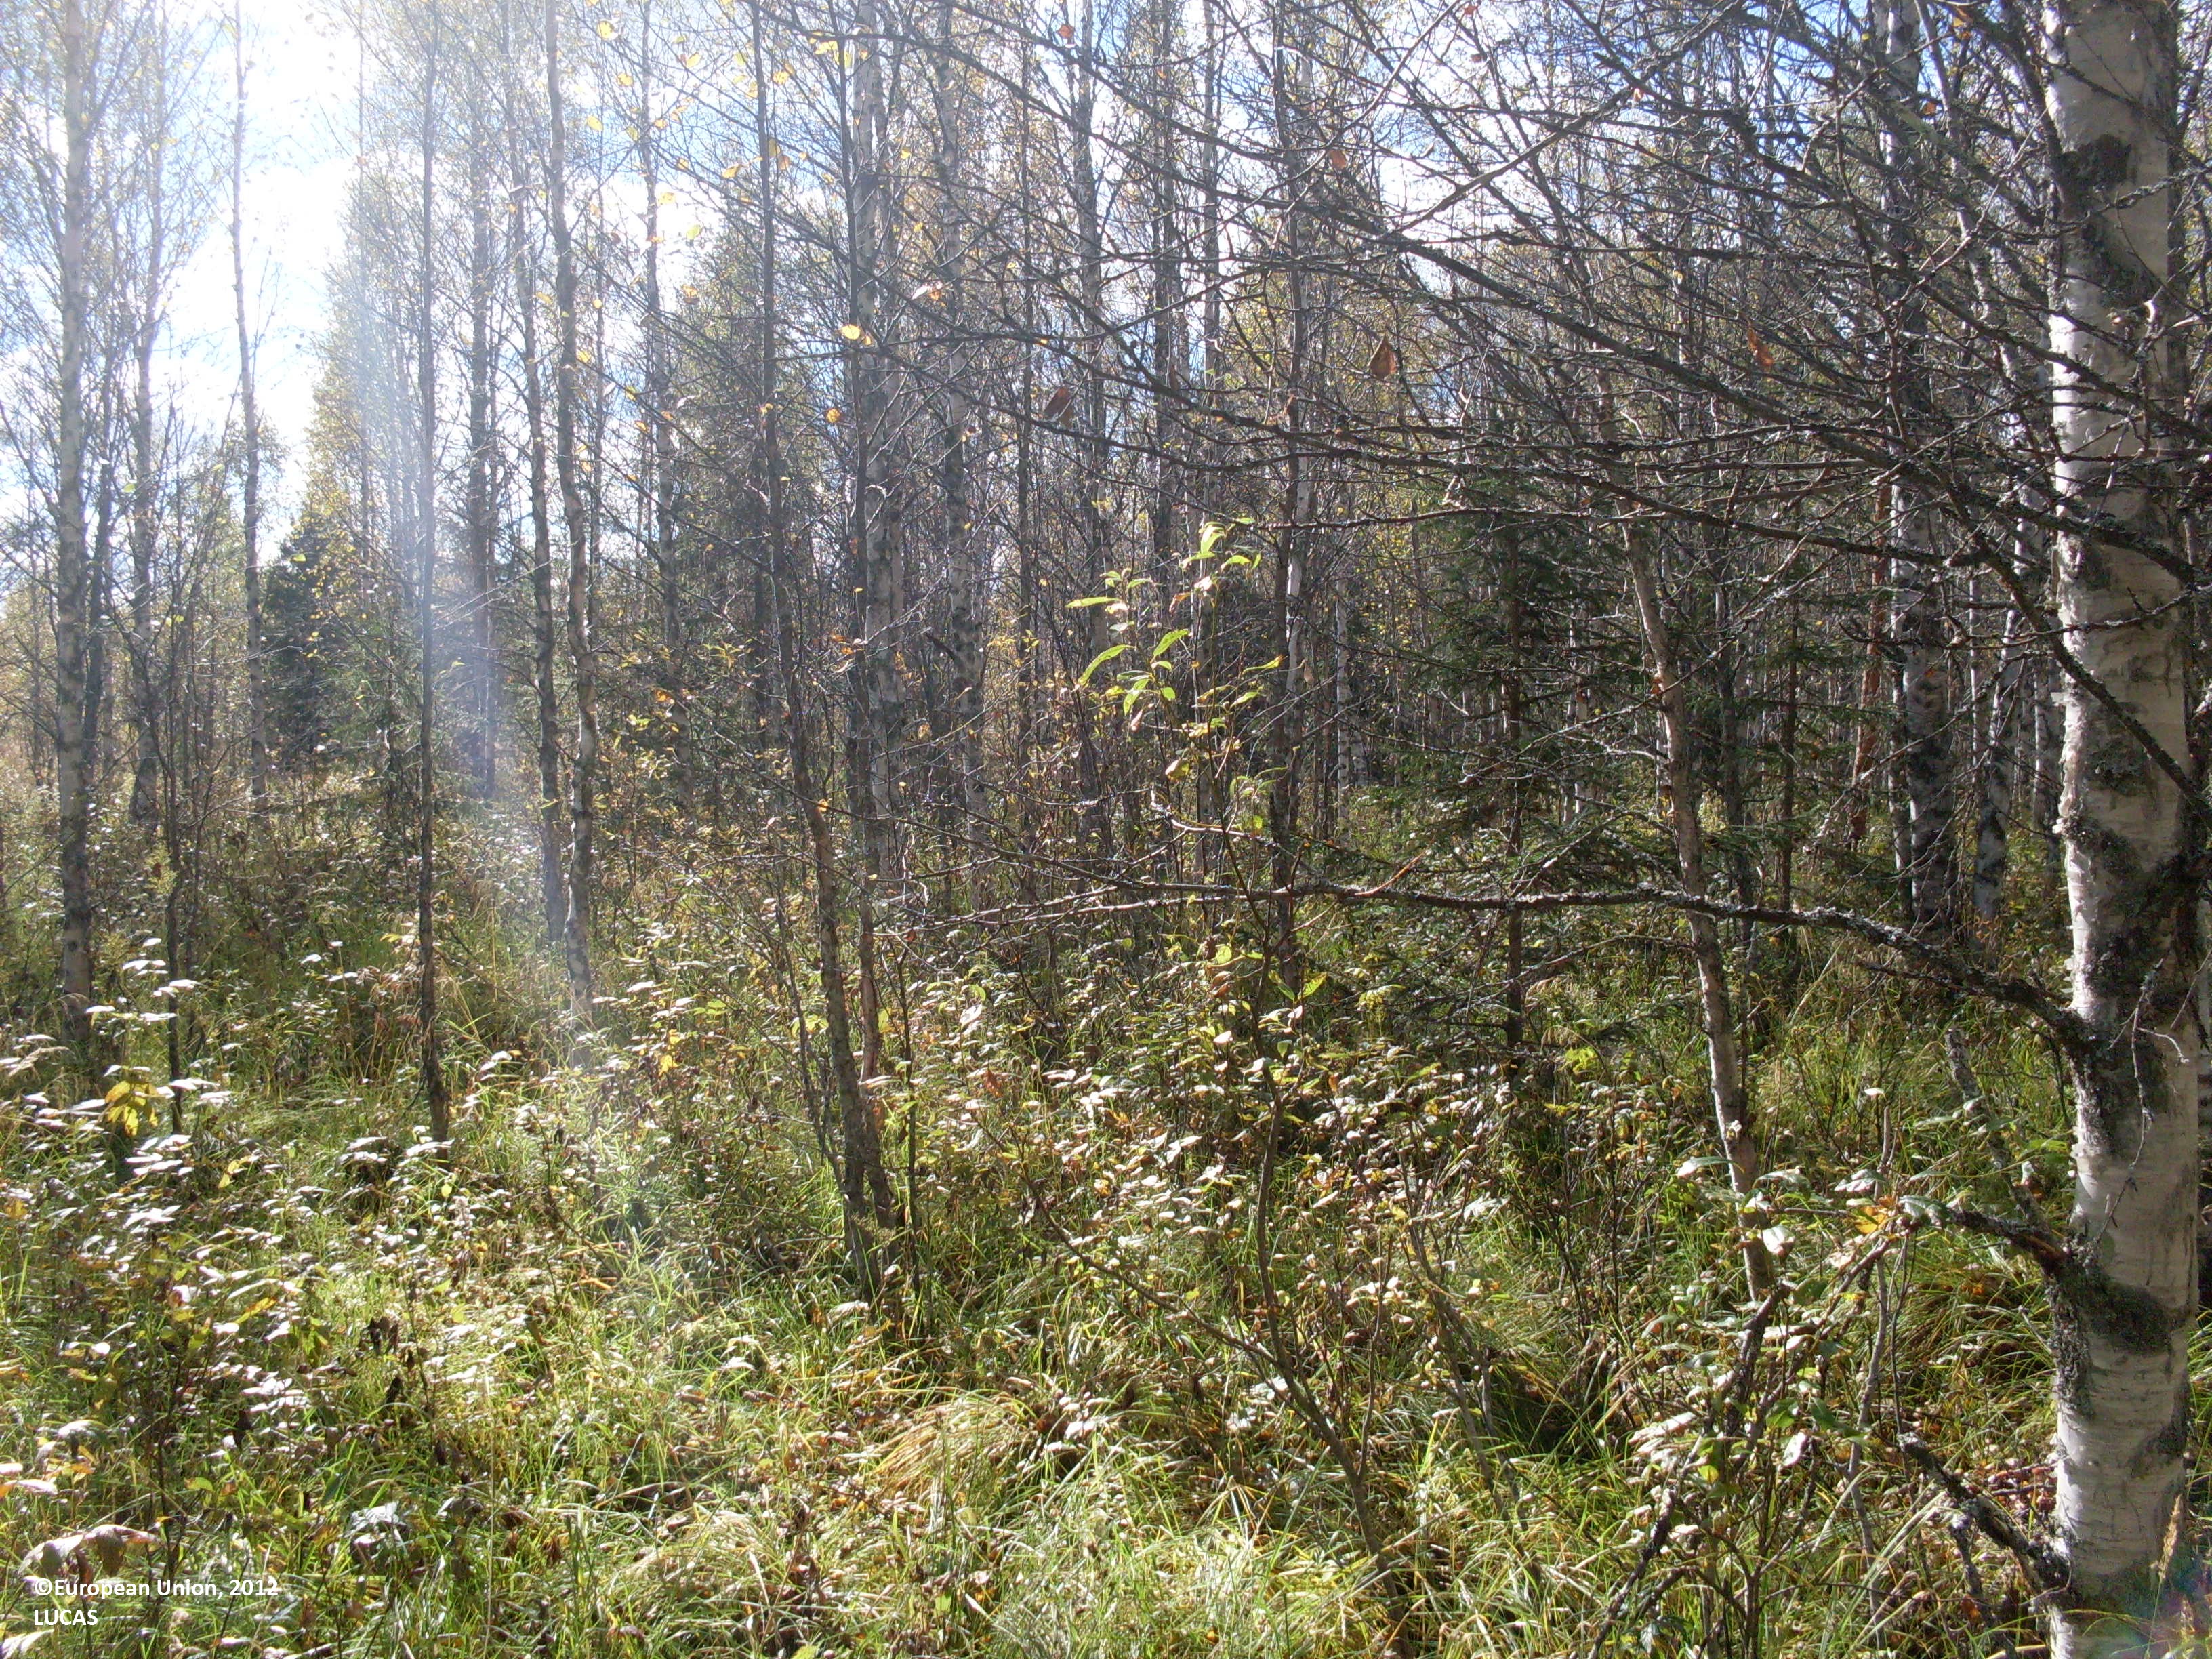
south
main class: Woodland
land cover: Other mixed woodland
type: boreal forest
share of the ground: 50 - 75 %
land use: Forestry
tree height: > 5 m
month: September
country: FI
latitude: 64.1093
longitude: 30.0492
